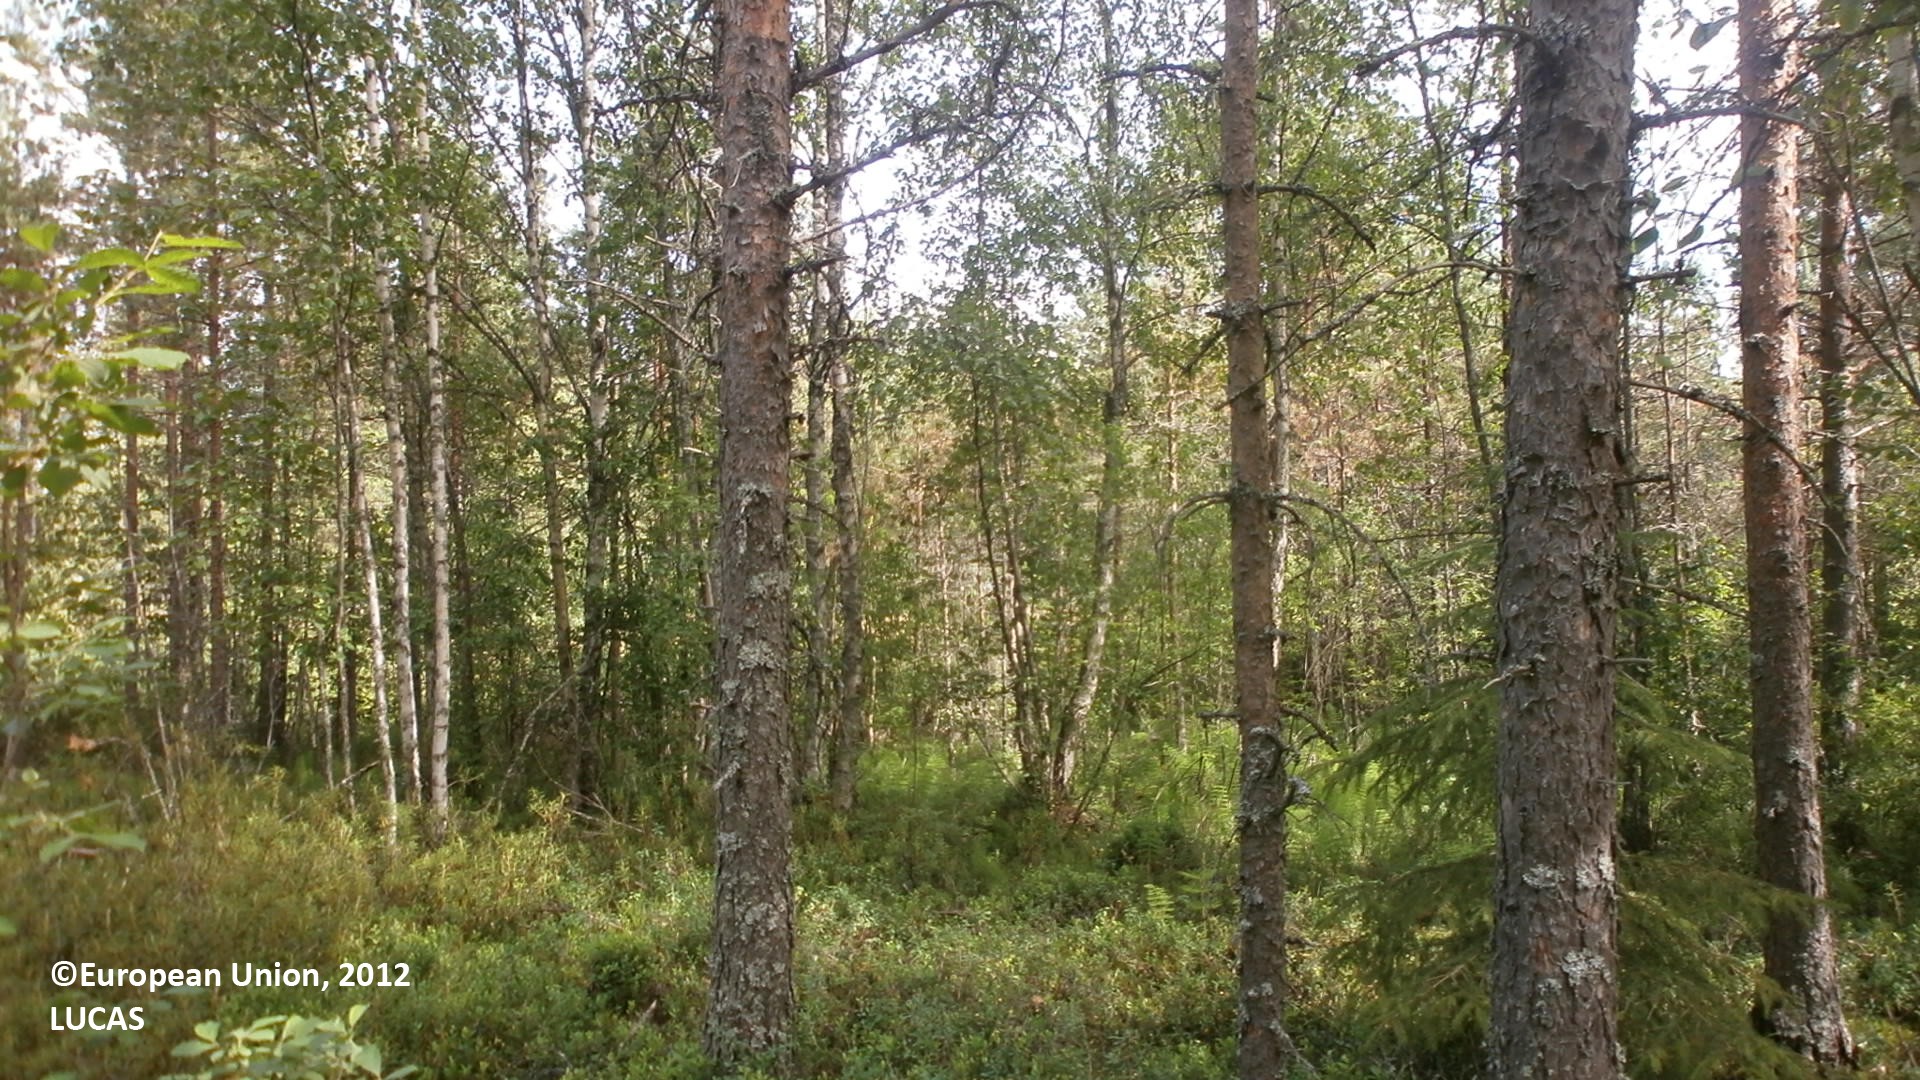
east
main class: Woodland
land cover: Pine dominated mixed woodland
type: boreal forest
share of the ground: 50 - 75 %
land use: Forestry
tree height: > 5 m
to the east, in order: Pine dominated mixed woodland; Ditches and canals; Grassland with sparse tree/shrub cover; Tracks; Spontaneously vegetated surfaces; Pine dominated mixed woodland; Ditches and canals; Pine dominated mixed woodland; Pine dominated coniferous woodland; Pine dominated mixed woodland; Ditches and canals; Pine dominated mixed woodland
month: July
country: FI
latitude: 64.2349
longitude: 24.1904
